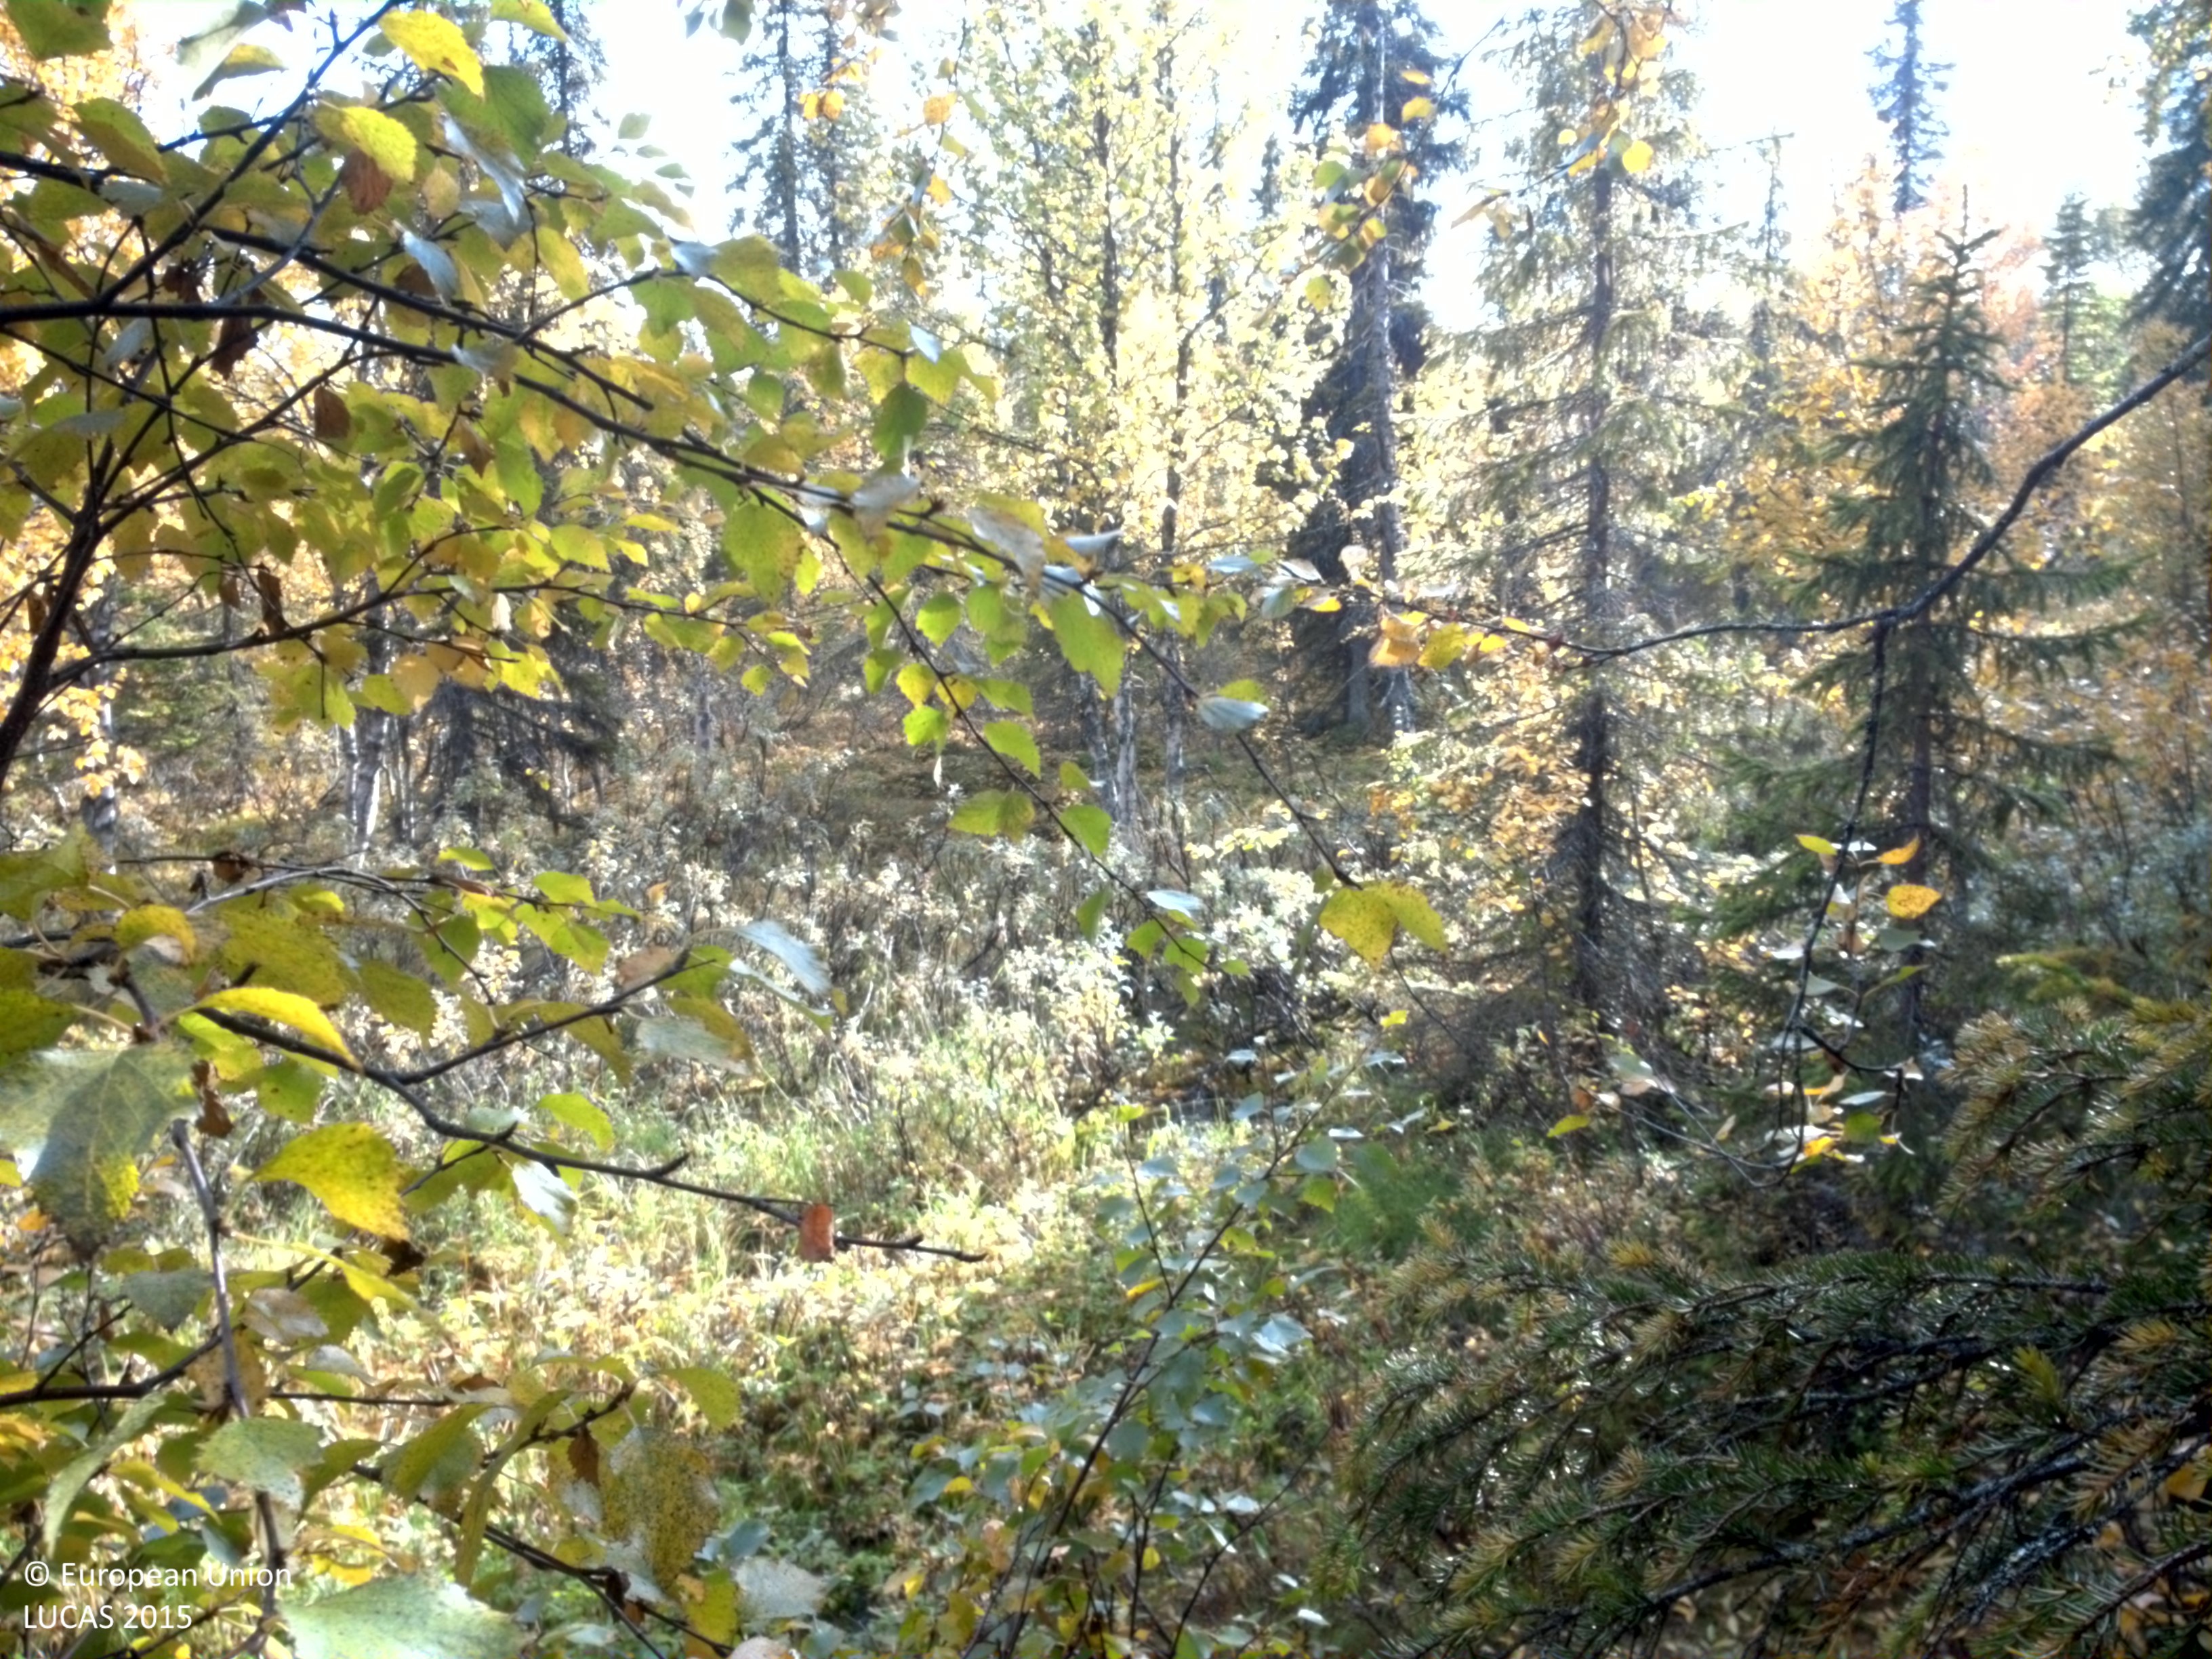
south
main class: Woodland
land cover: Spruce dominated mixed woodland
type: boreal forest
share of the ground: 25 - 50 %
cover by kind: shrubs 40 %, coniferous forest trees 20 %, broadleaved forest trees 15 %, herbaceous plants 15 %, lichens and mosses 10 %
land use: Forestry
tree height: > 5 m
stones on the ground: < 10 %
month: September
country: SE
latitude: 65.2828
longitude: 16.8851
